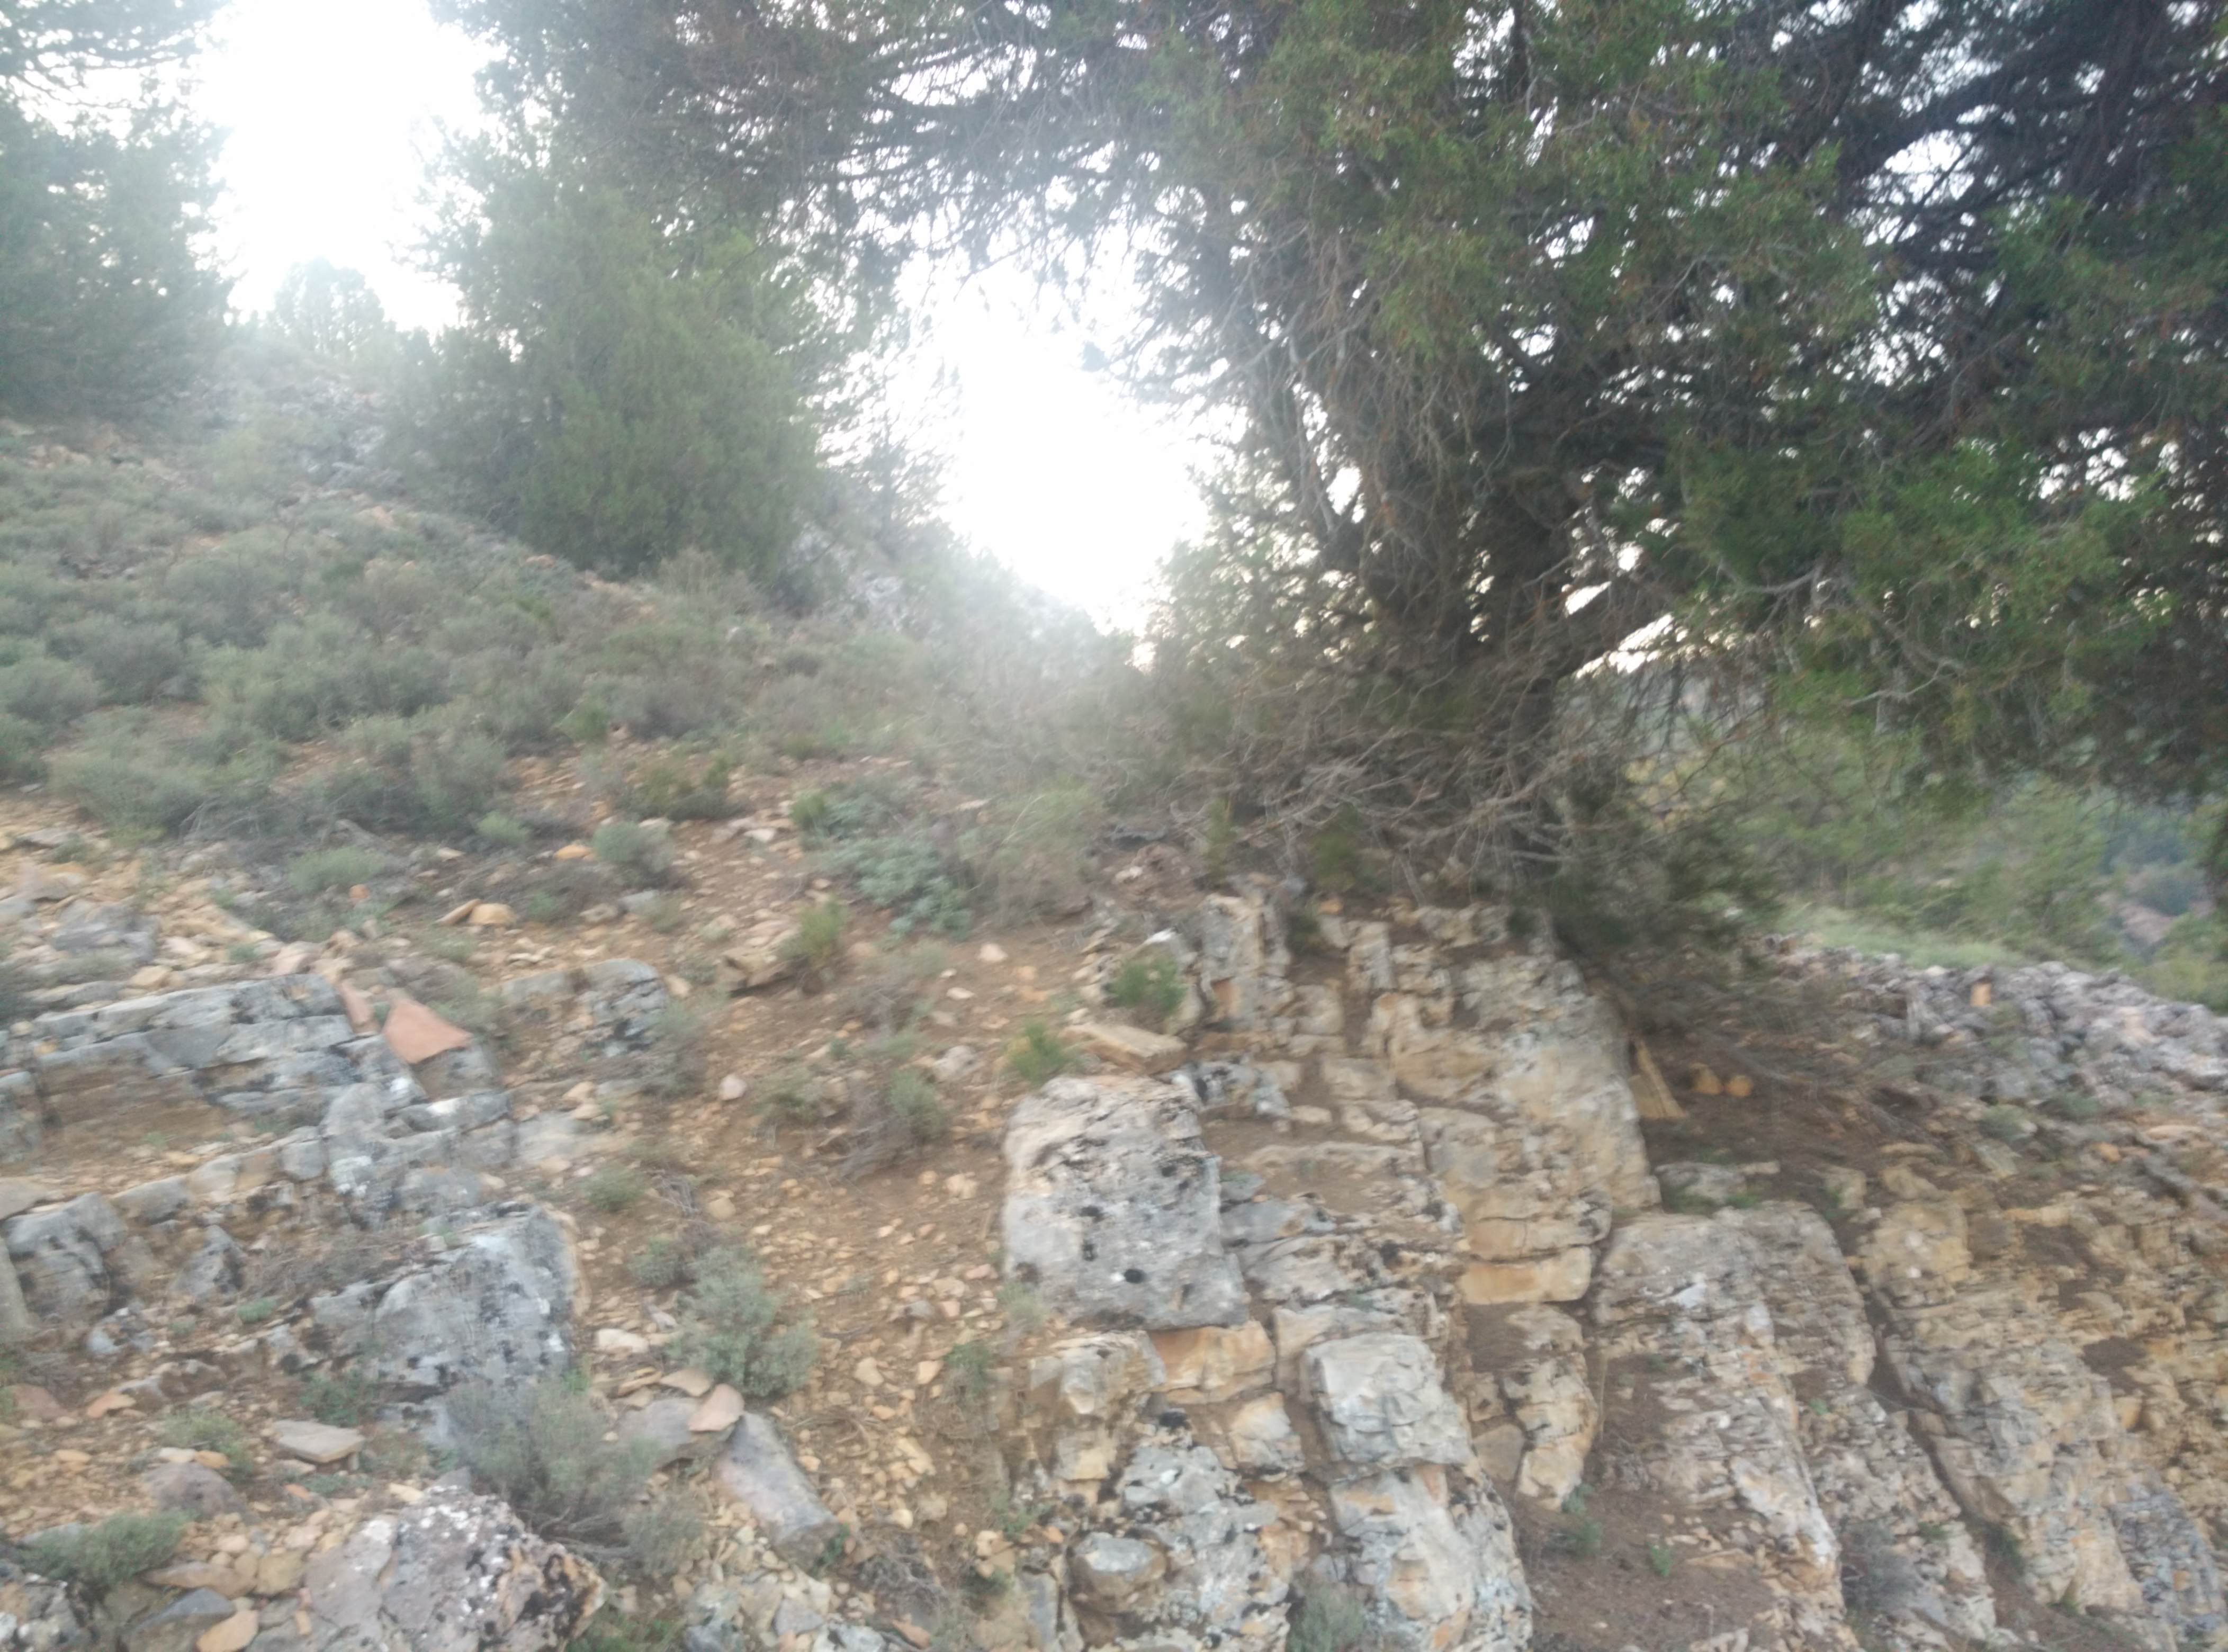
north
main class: Woodland
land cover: Other coniferous woodland
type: coniferous forest of the mediterranean region
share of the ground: 25 - 50 %
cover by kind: unconsolidated bare surface 60 %, coniferous forest trees 30 %, shrubs 10 %
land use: Semi-natural and natural areas not in use
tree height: > 5 m
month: June
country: ES
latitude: 40.7700
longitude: -2.0002
